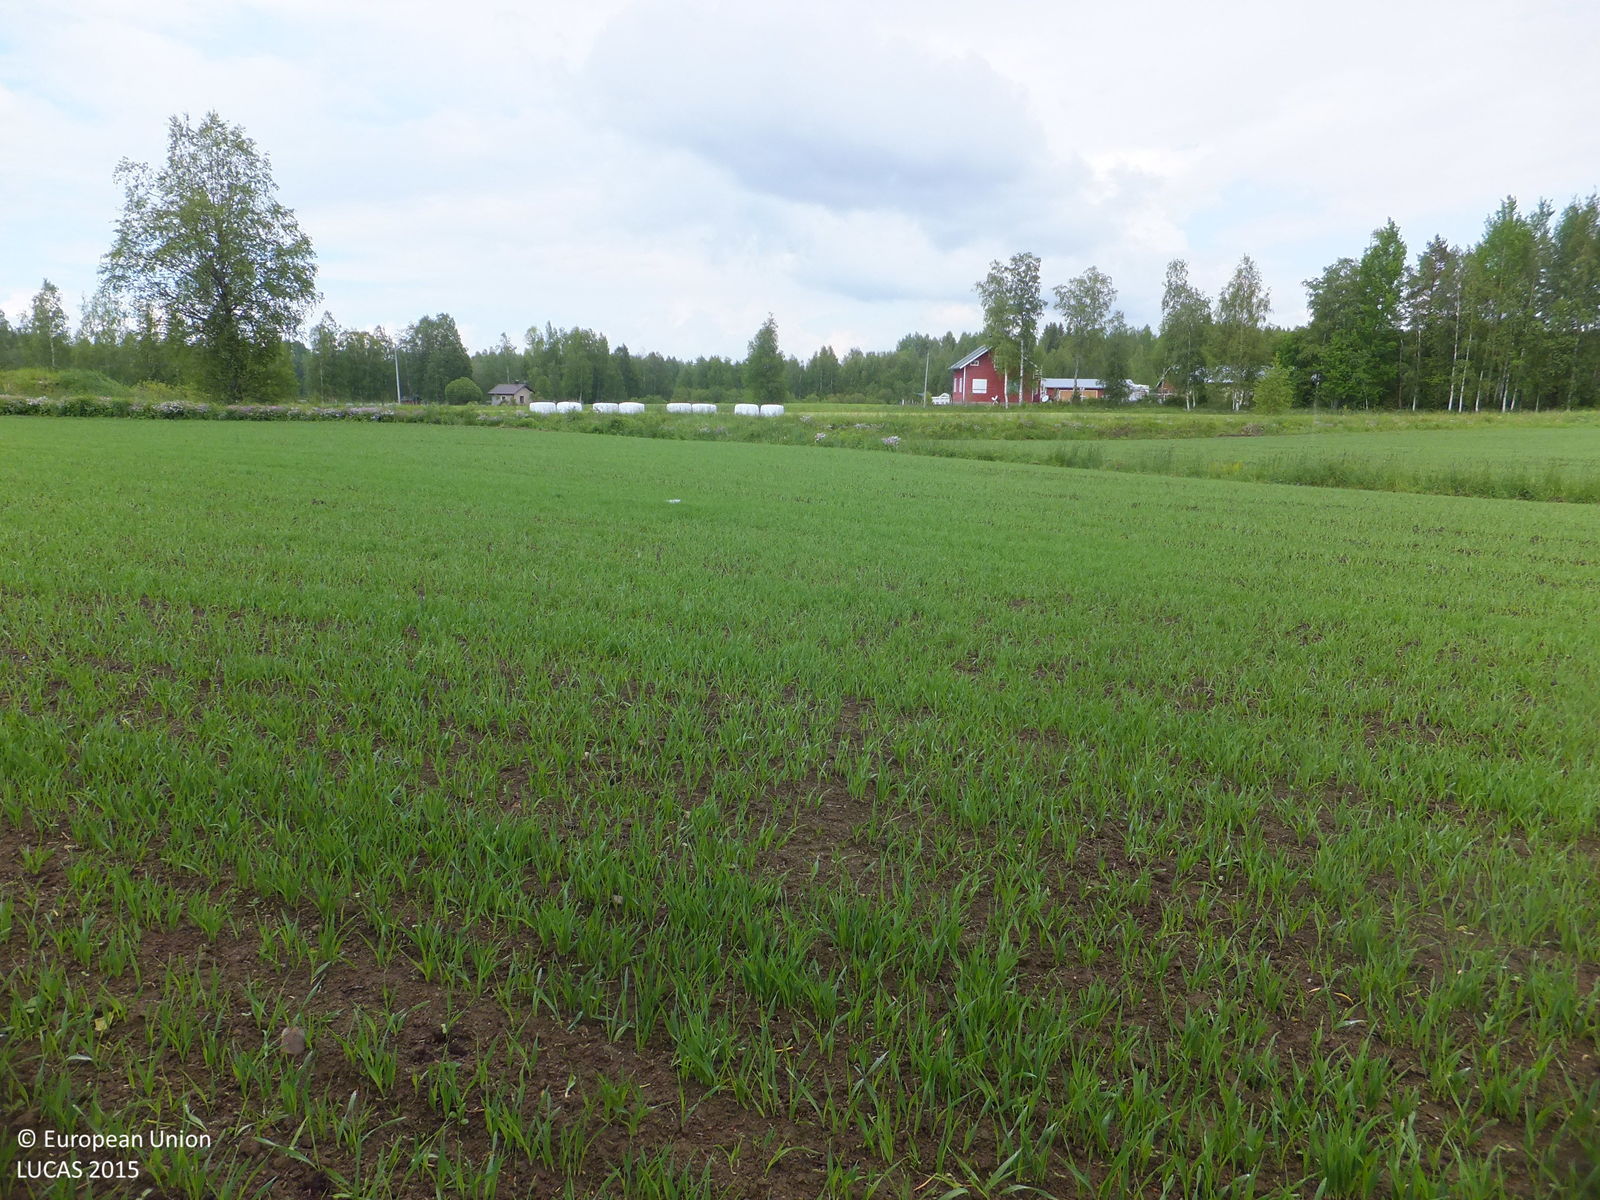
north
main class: Cropland
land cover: Barley
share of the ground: > 75 %
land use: Agriculture (excluding fallow land and kitchen gardens)
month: June
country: FI
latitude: 63.6165
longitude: 25.0769
